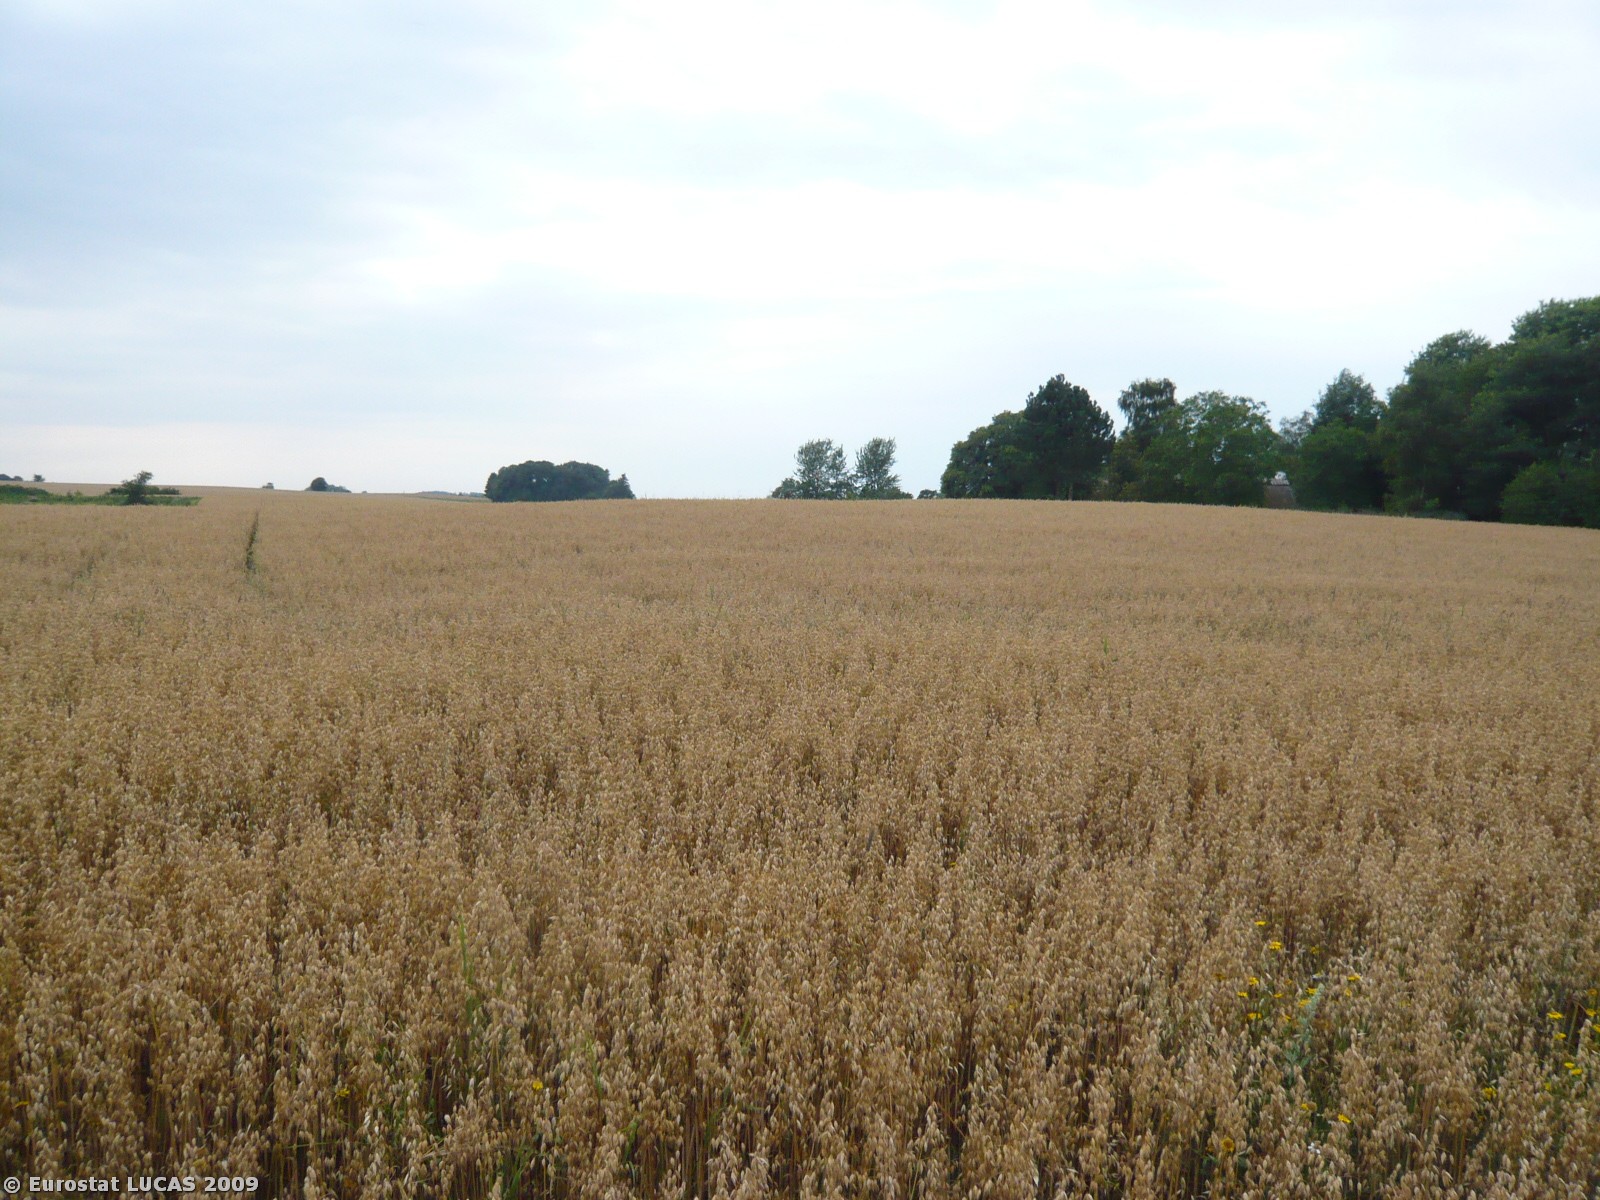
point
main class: Cropland
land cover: Oats
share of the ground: > 75 %
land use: Agriculture (excluding fallow land and kitchen gardens)
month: July
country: DK
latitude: 55.8640
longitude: 12.1551
